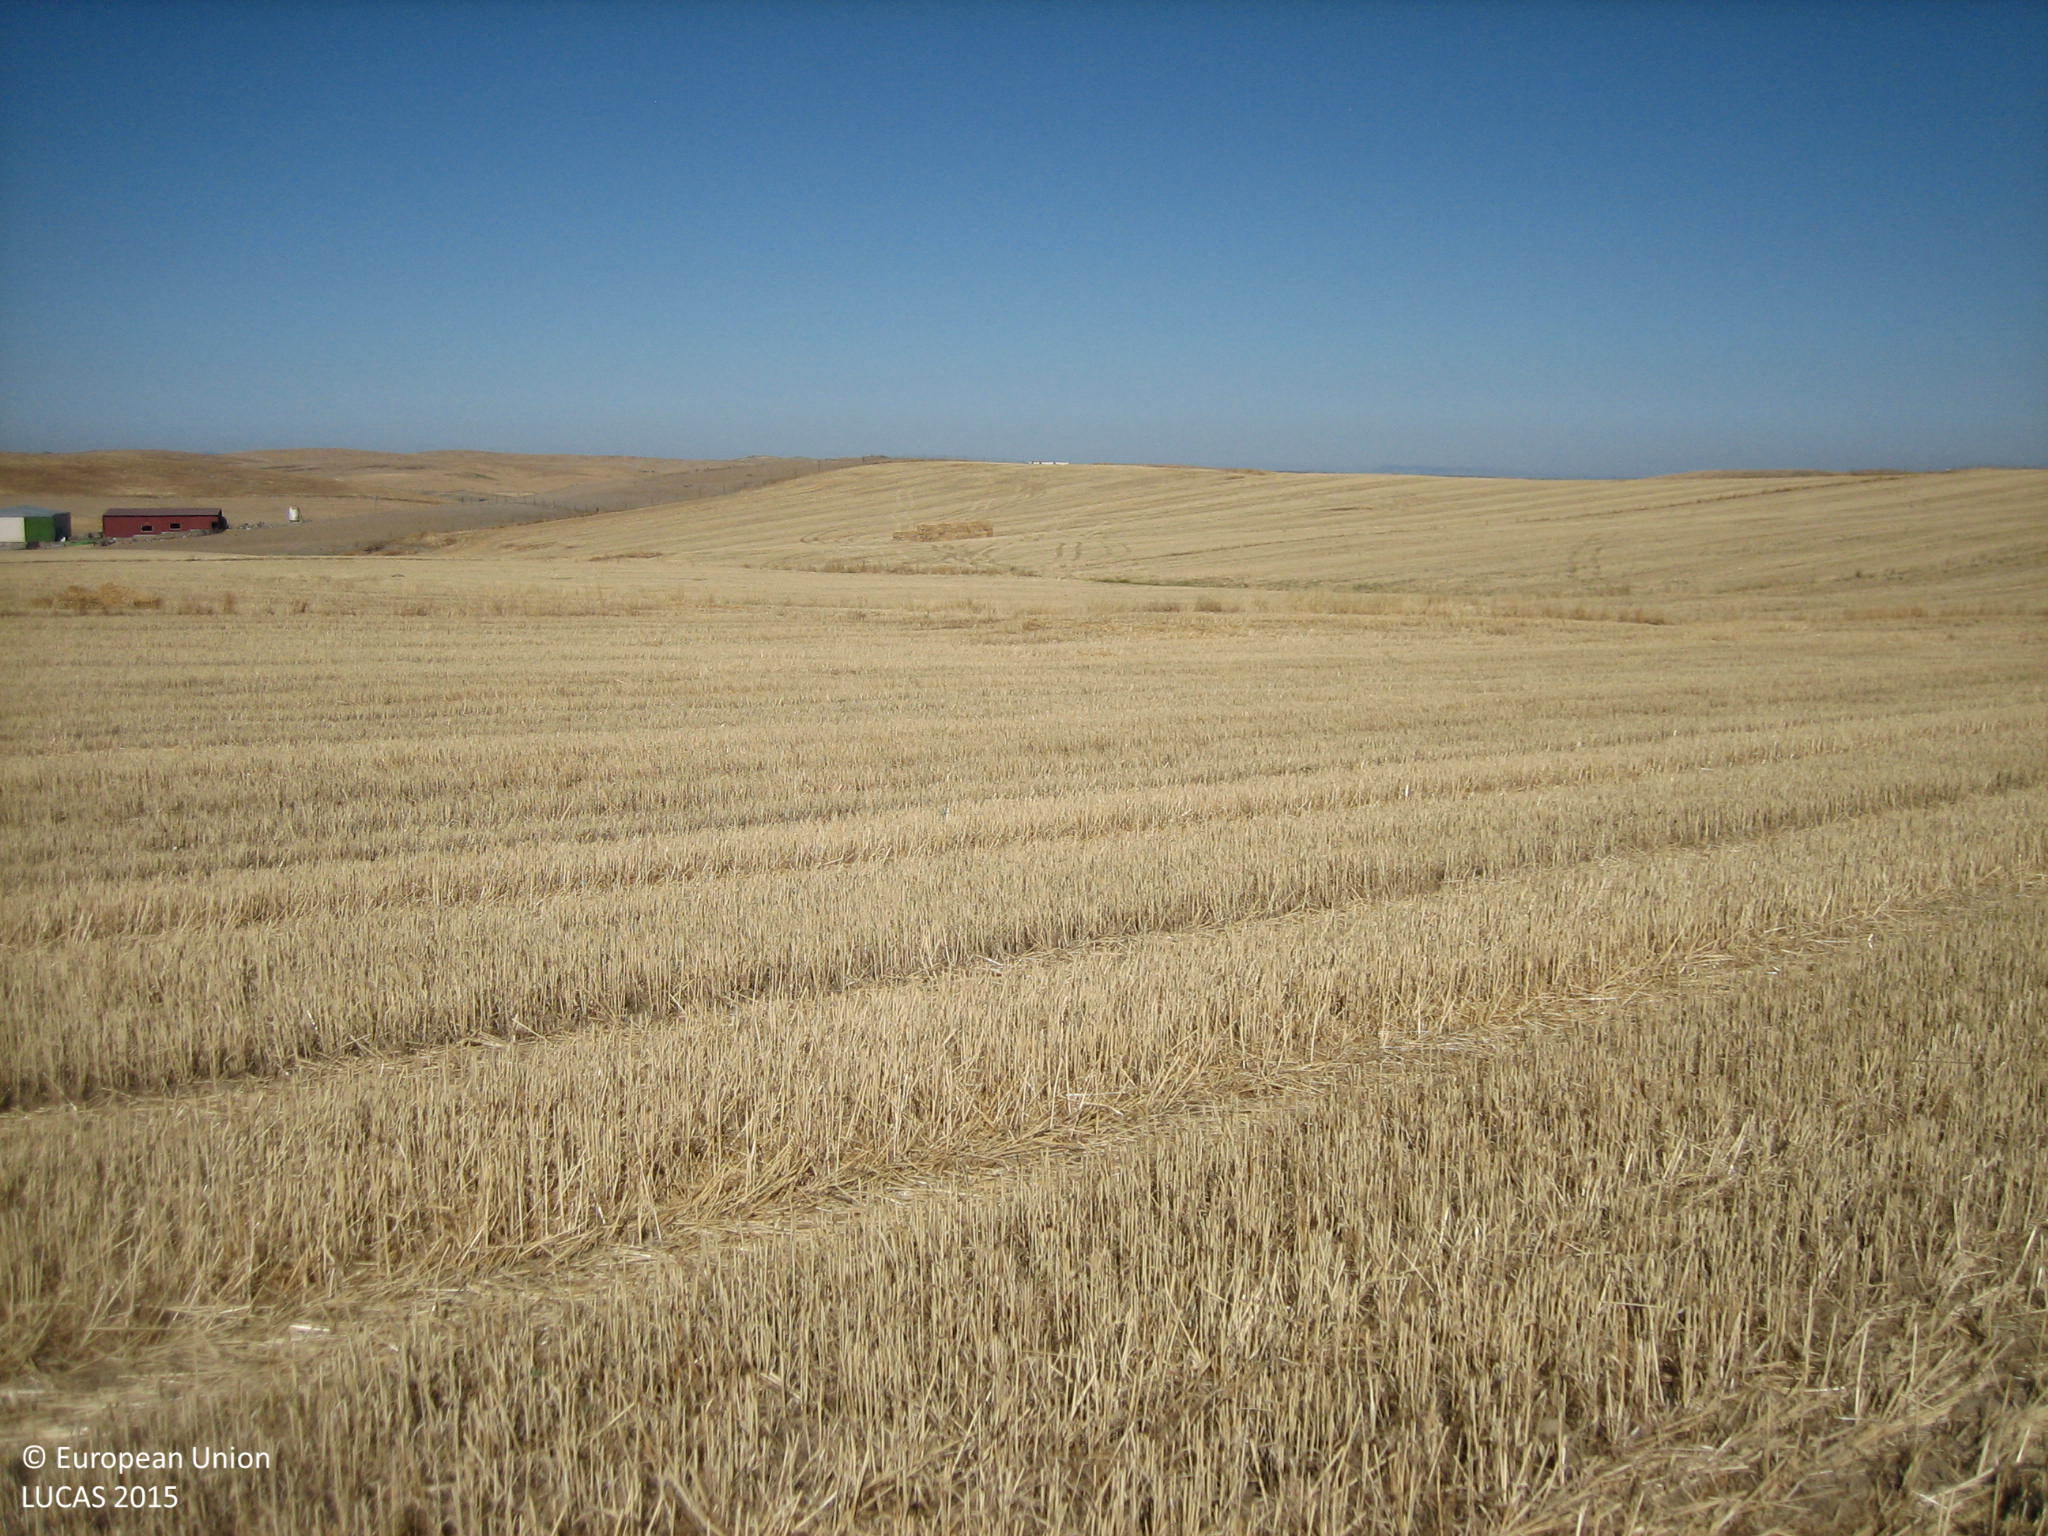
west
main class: Cropland
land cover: Common wheat
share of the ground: < 10 %
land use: Agriculture (excluding fallow land and kitchen gardens)
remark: Harvested field
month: July
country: ES
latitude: 38.2304
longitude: -6.3008
